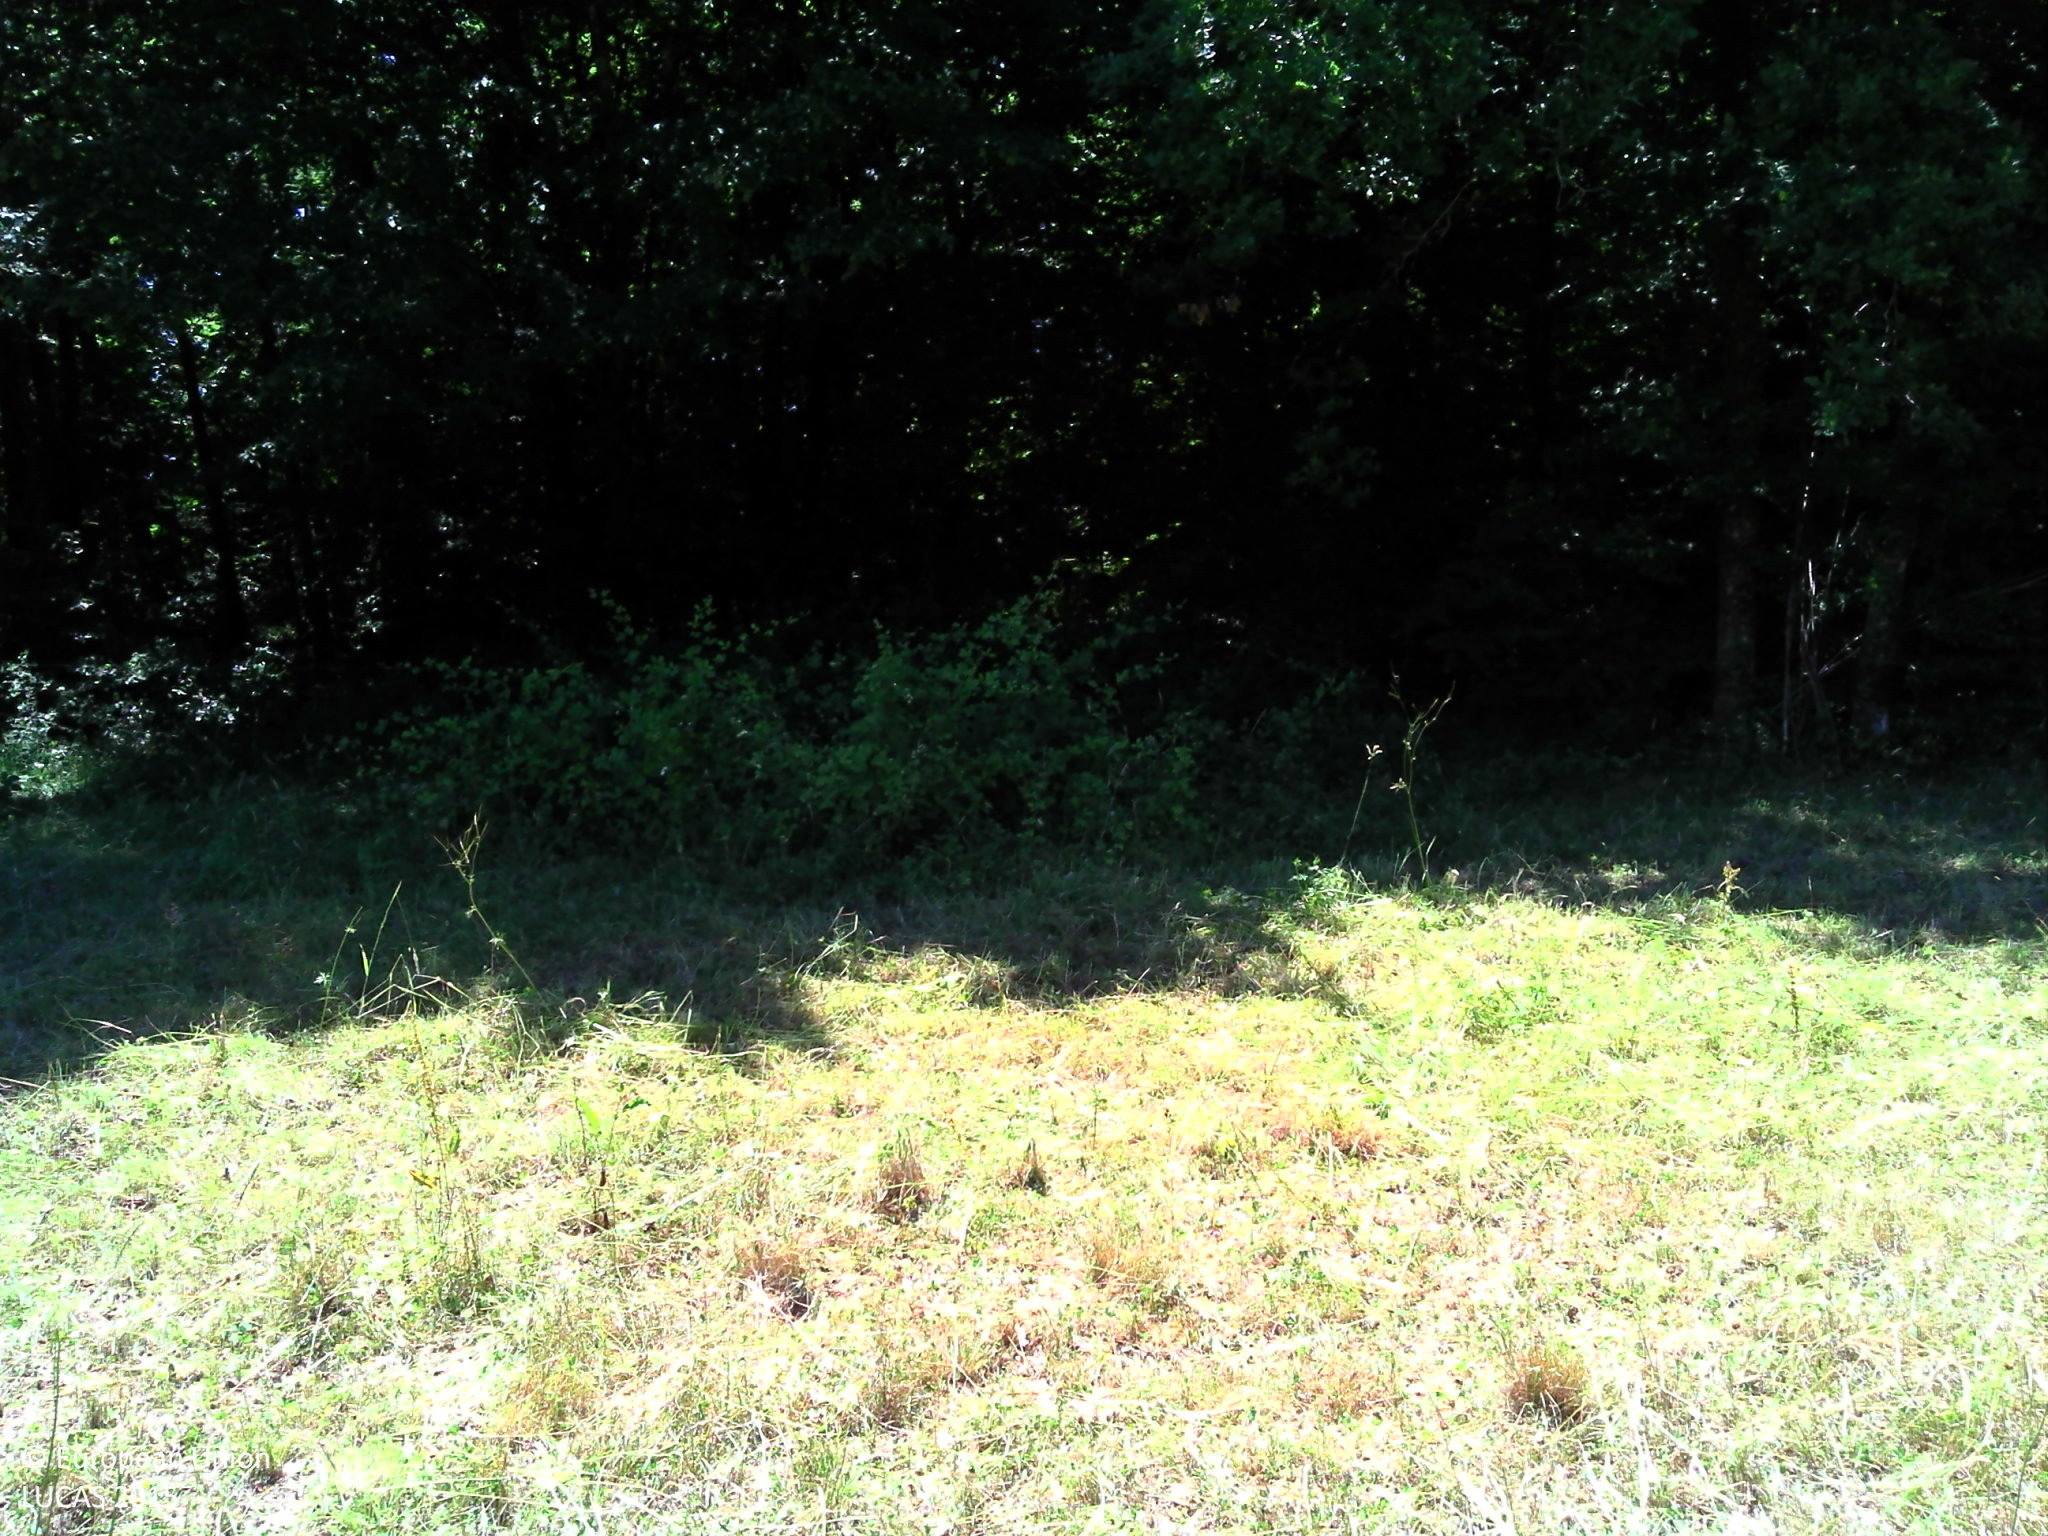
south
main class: Grassland
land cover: Grassland without tree/shrub cover
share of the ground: > 75 %
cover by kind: herbaceous plants 100 %
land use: Agriculture (excluding fallow land and kitchen gardens)
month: June
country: FR
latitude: 45.6597
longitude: 0.3467
